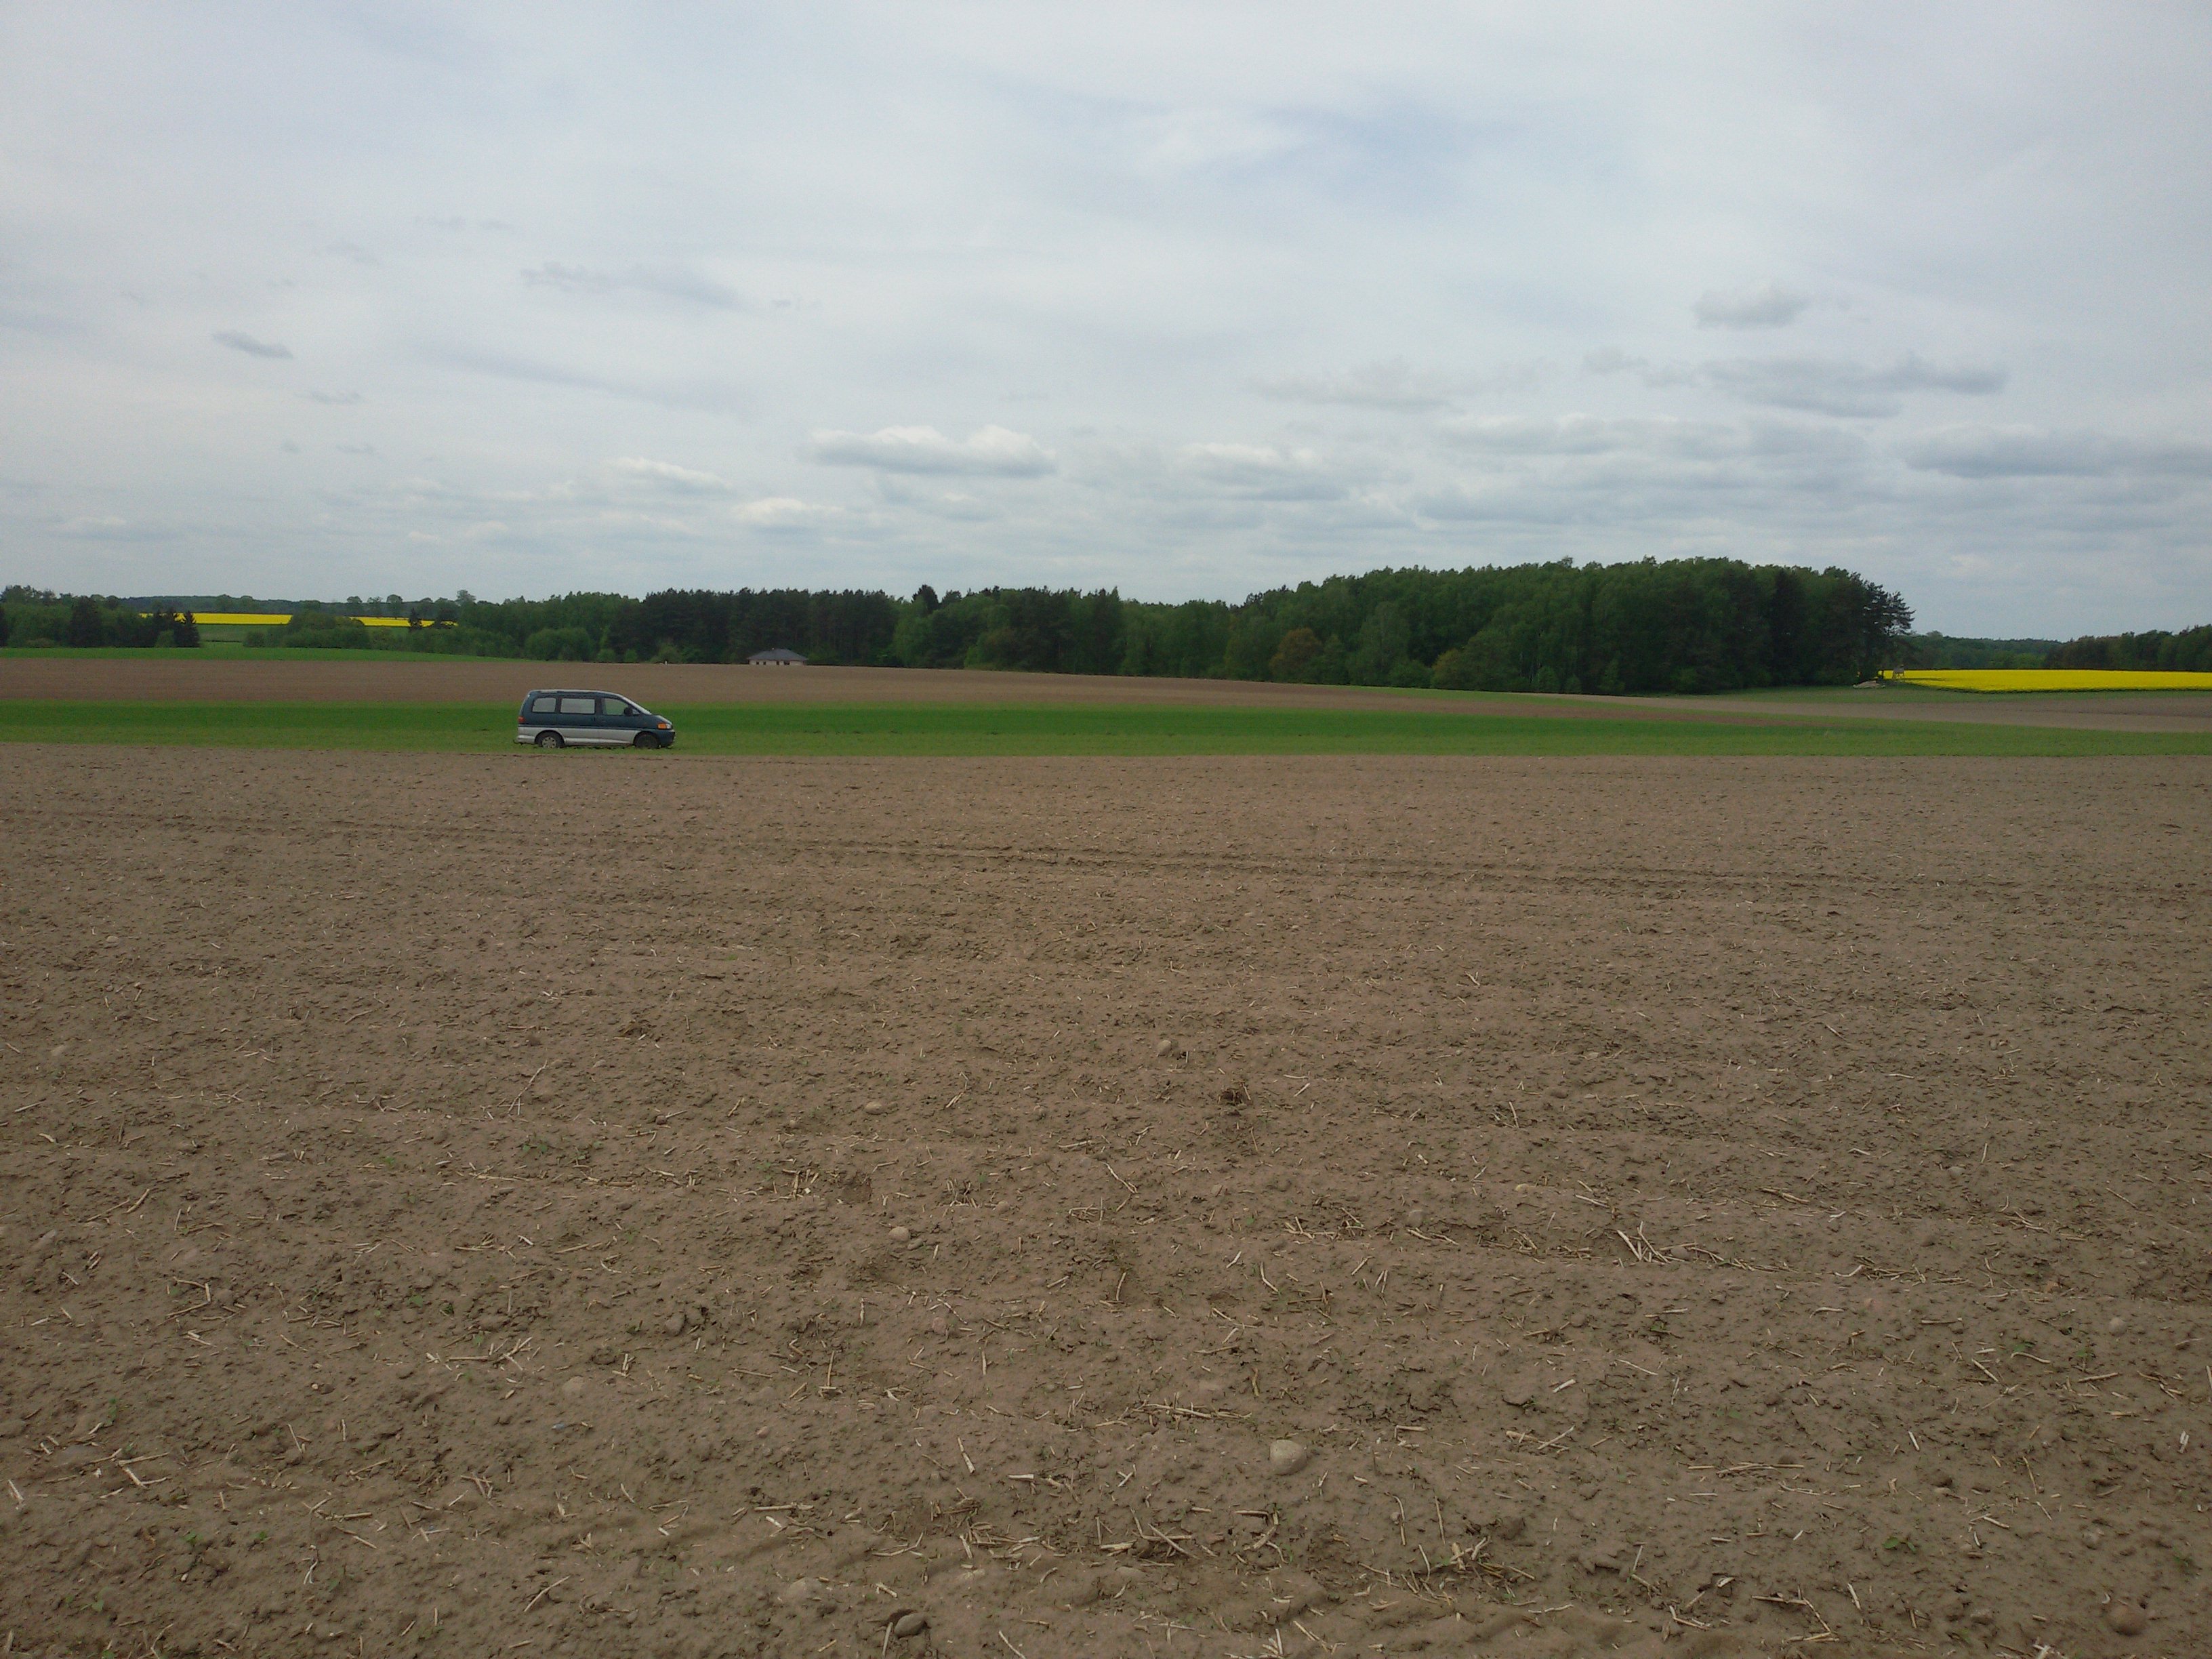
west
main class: Cropland
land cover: Common wheat
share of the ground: < 10 %
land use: Agriculture (excluding fallow land and kitchen gardens)
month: May
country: PL
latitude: 53.4979
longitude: 17.1401
